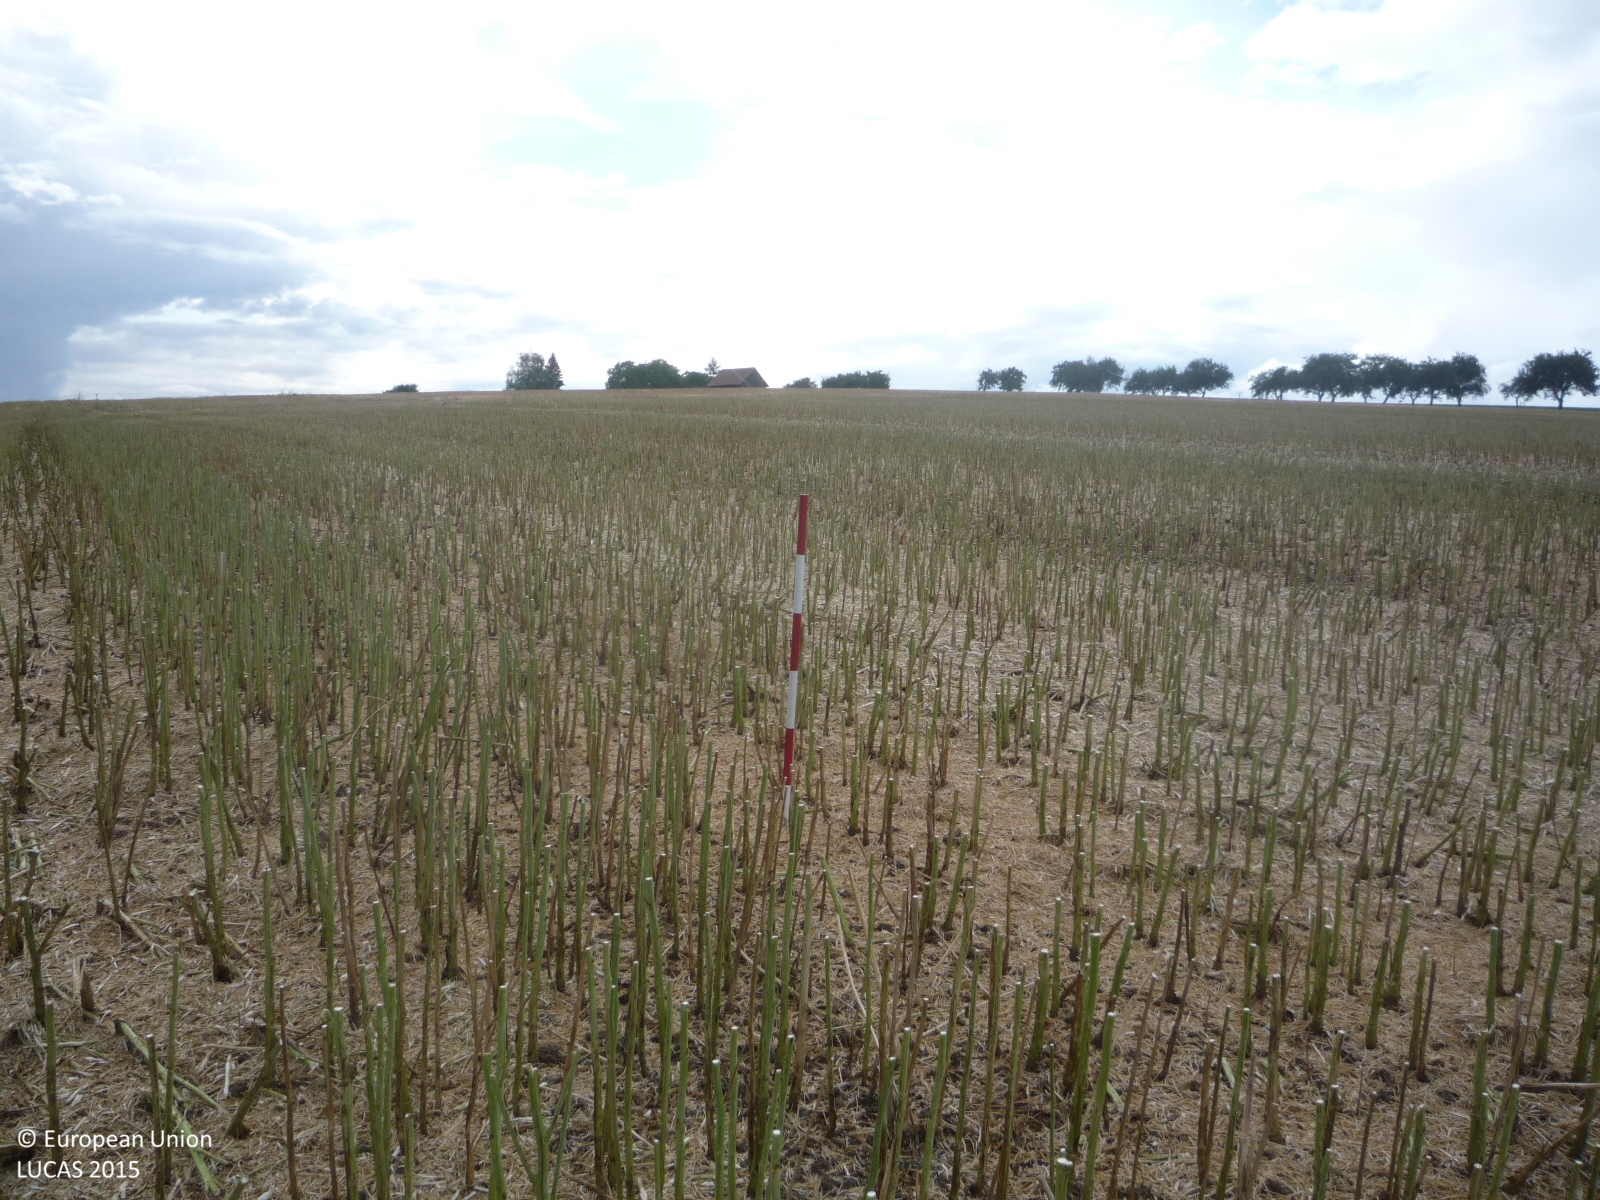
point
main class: Cropland
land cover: Rape and turnip rape
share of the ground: 50 - 75 %
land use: Agriculture (excluding fallow land and kitchen gardens)
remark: Harvested field
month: July
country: CZ
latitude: 50.3685
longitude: 15.2757
